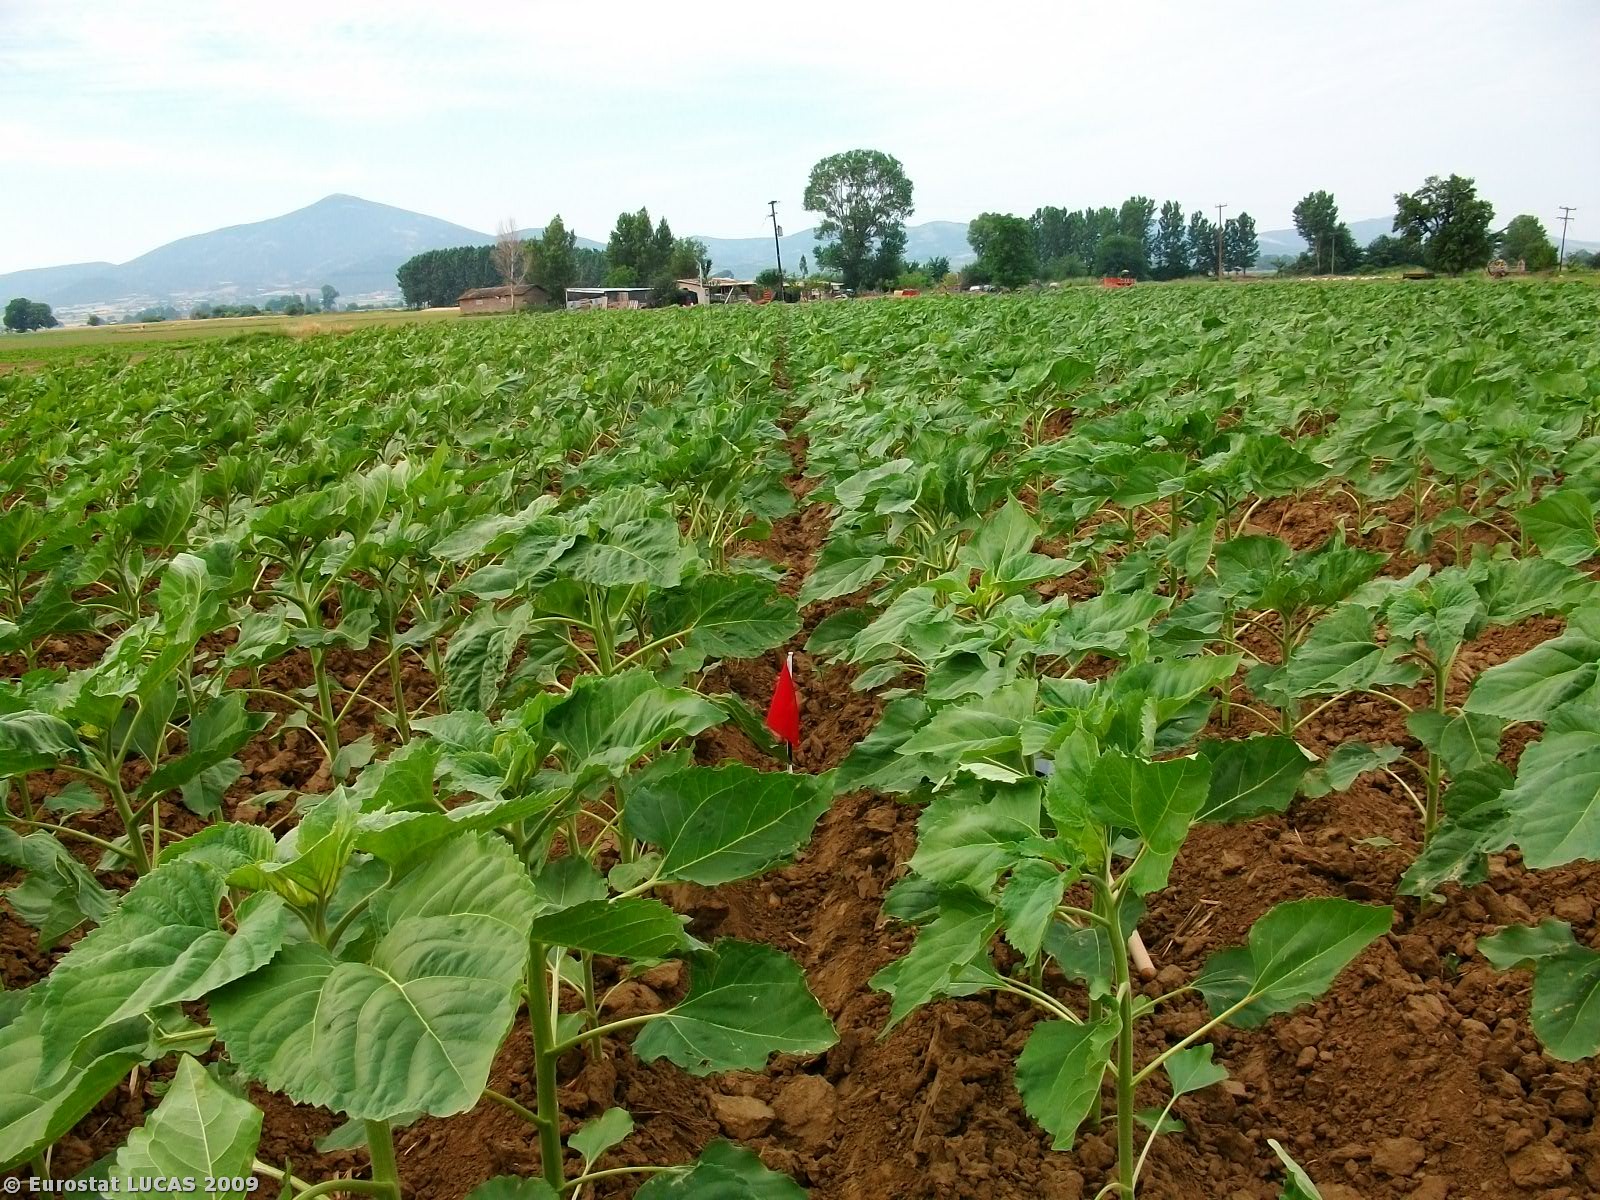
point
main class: Cropland
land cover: Sunflower
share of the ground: > 75 %
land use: Agriculture (excluding fallow land and kitchen gardens)
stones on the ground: < 10 %
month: June
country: GR
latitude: 41.0476
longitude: 25.5058
